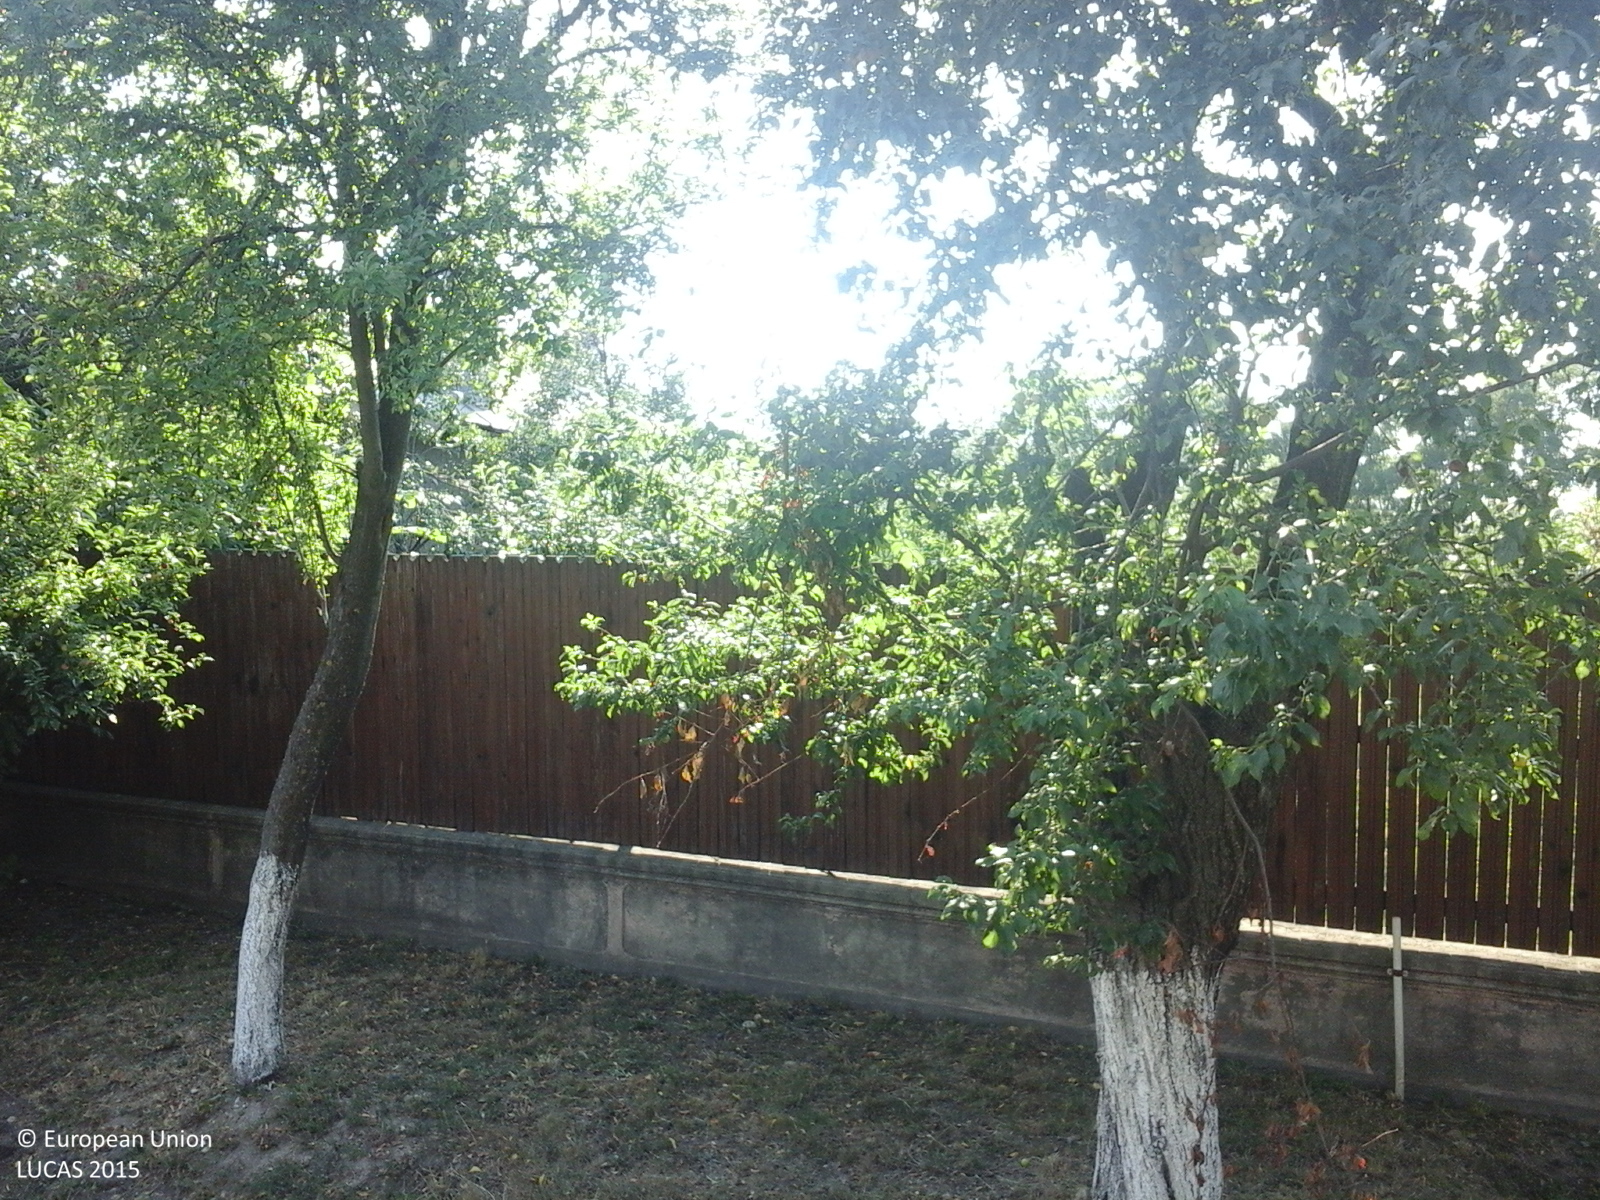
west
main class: Cropland
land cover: Apple fruit
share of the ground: > 75 %
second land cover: Grassland without tree/shrub cover
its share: > 75 %
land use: Agriculture (excluding fallow land and kitchen gardens)
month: July
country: RO
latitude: 44.5572
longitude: 25.5918
